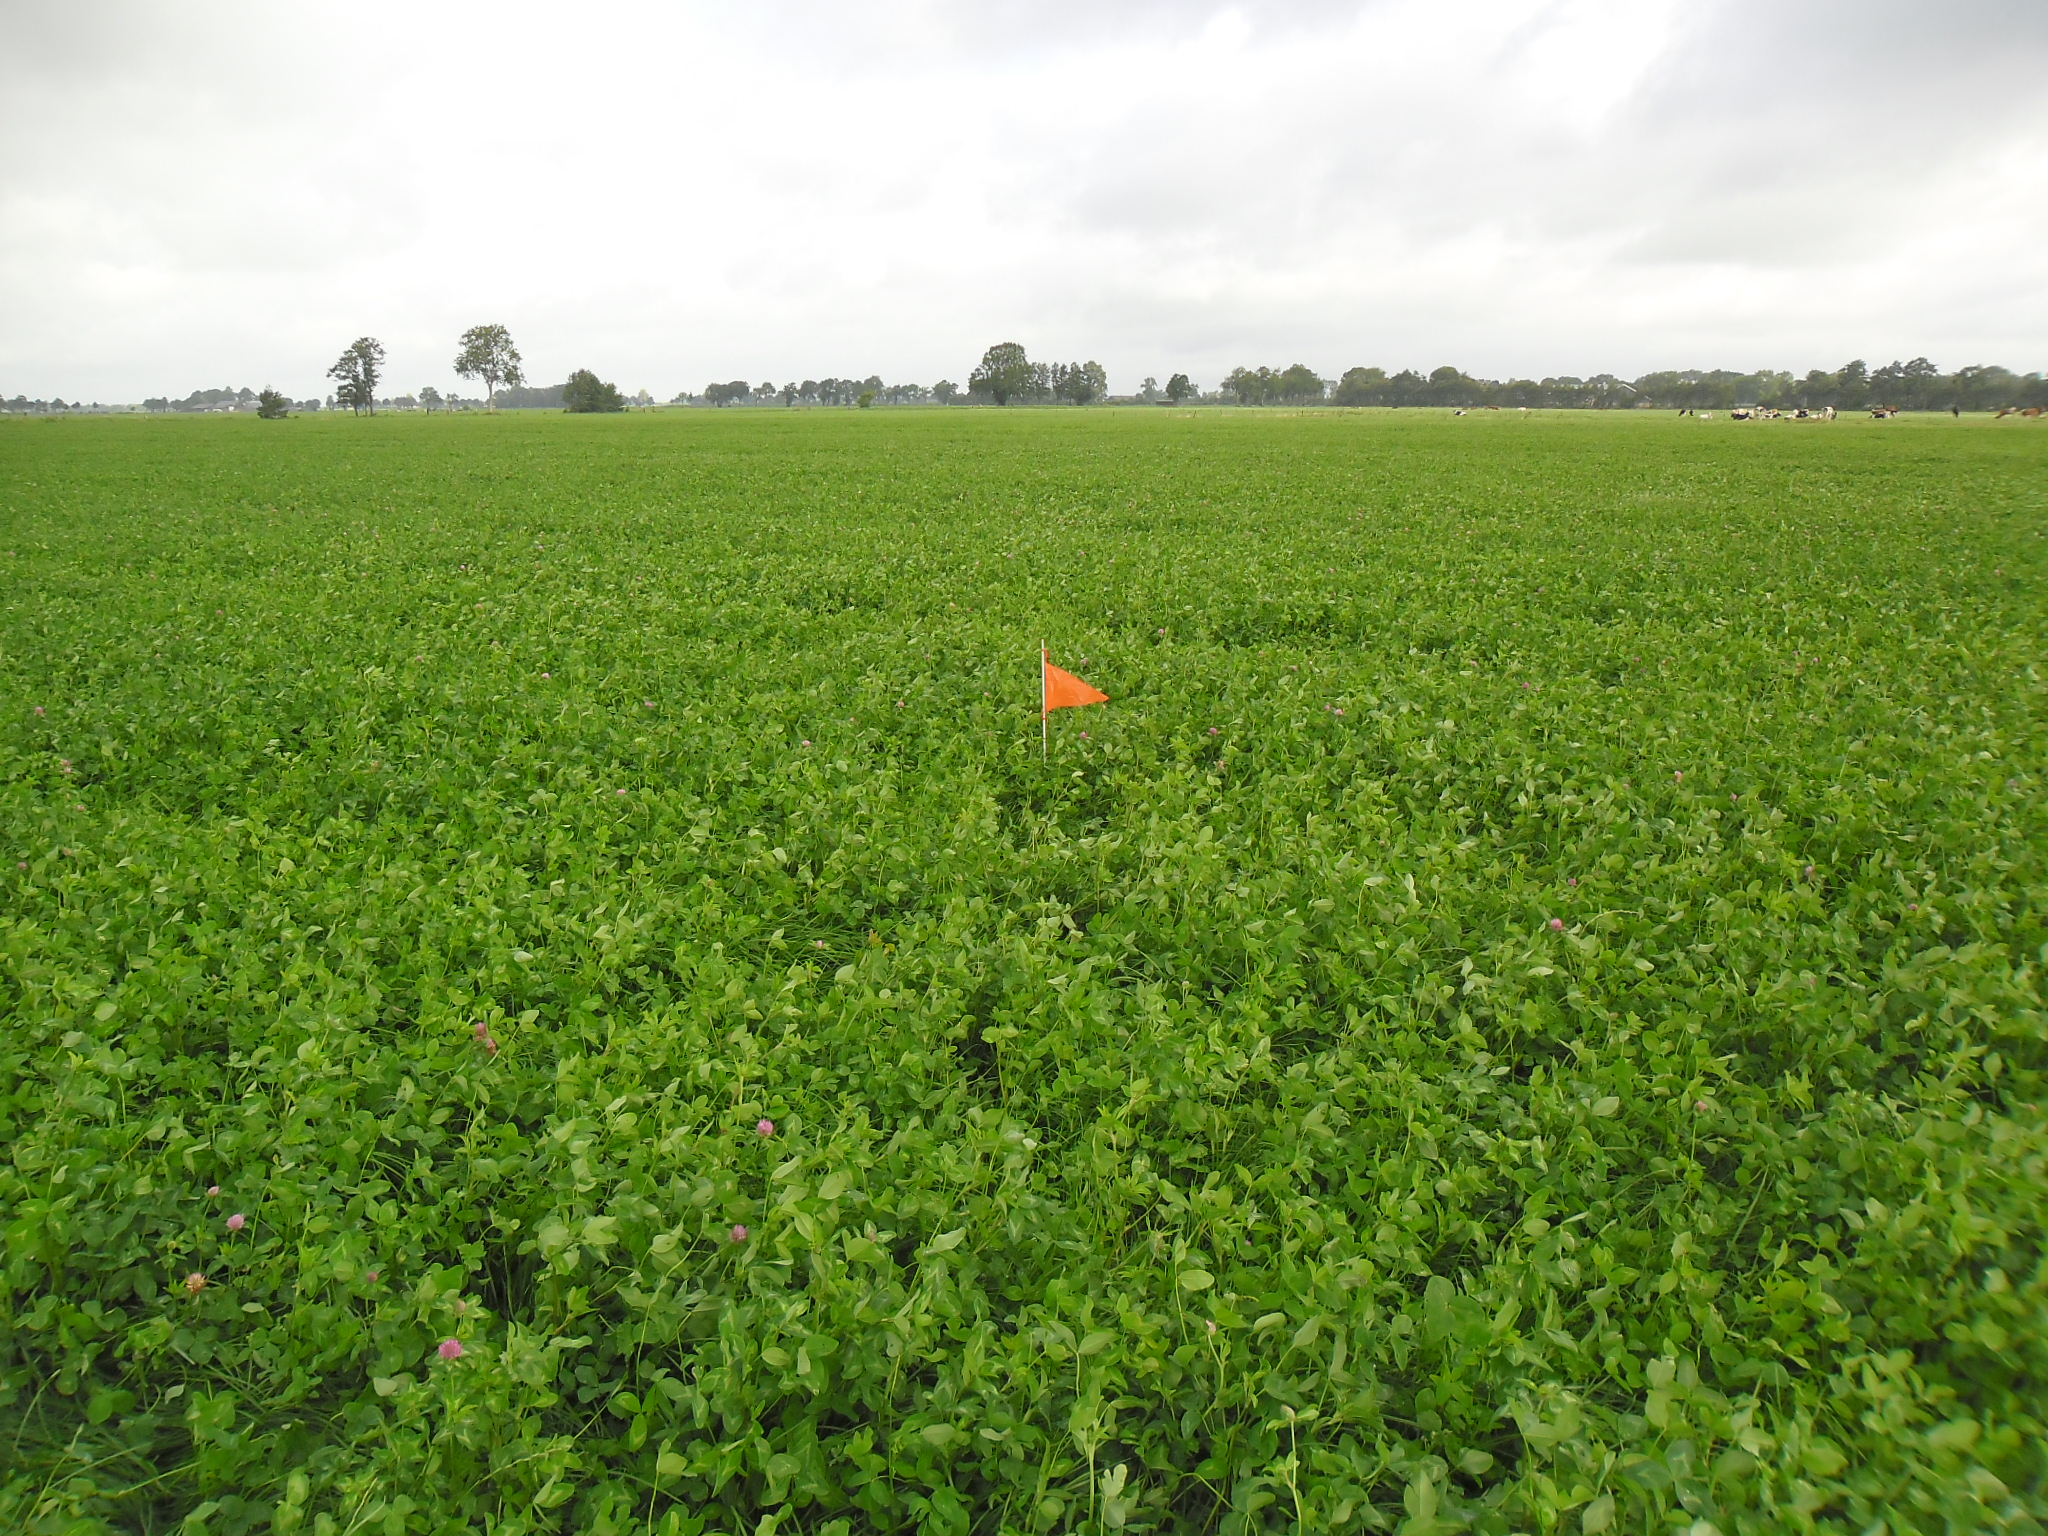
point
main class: Cropland
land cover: Other leguminous and mixtures for fodder
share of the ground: > 75 %
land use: Agriculture (excluding fallow land and kitchen gardens)
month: July
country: NL
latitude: 52.6218
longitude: 6.1736
